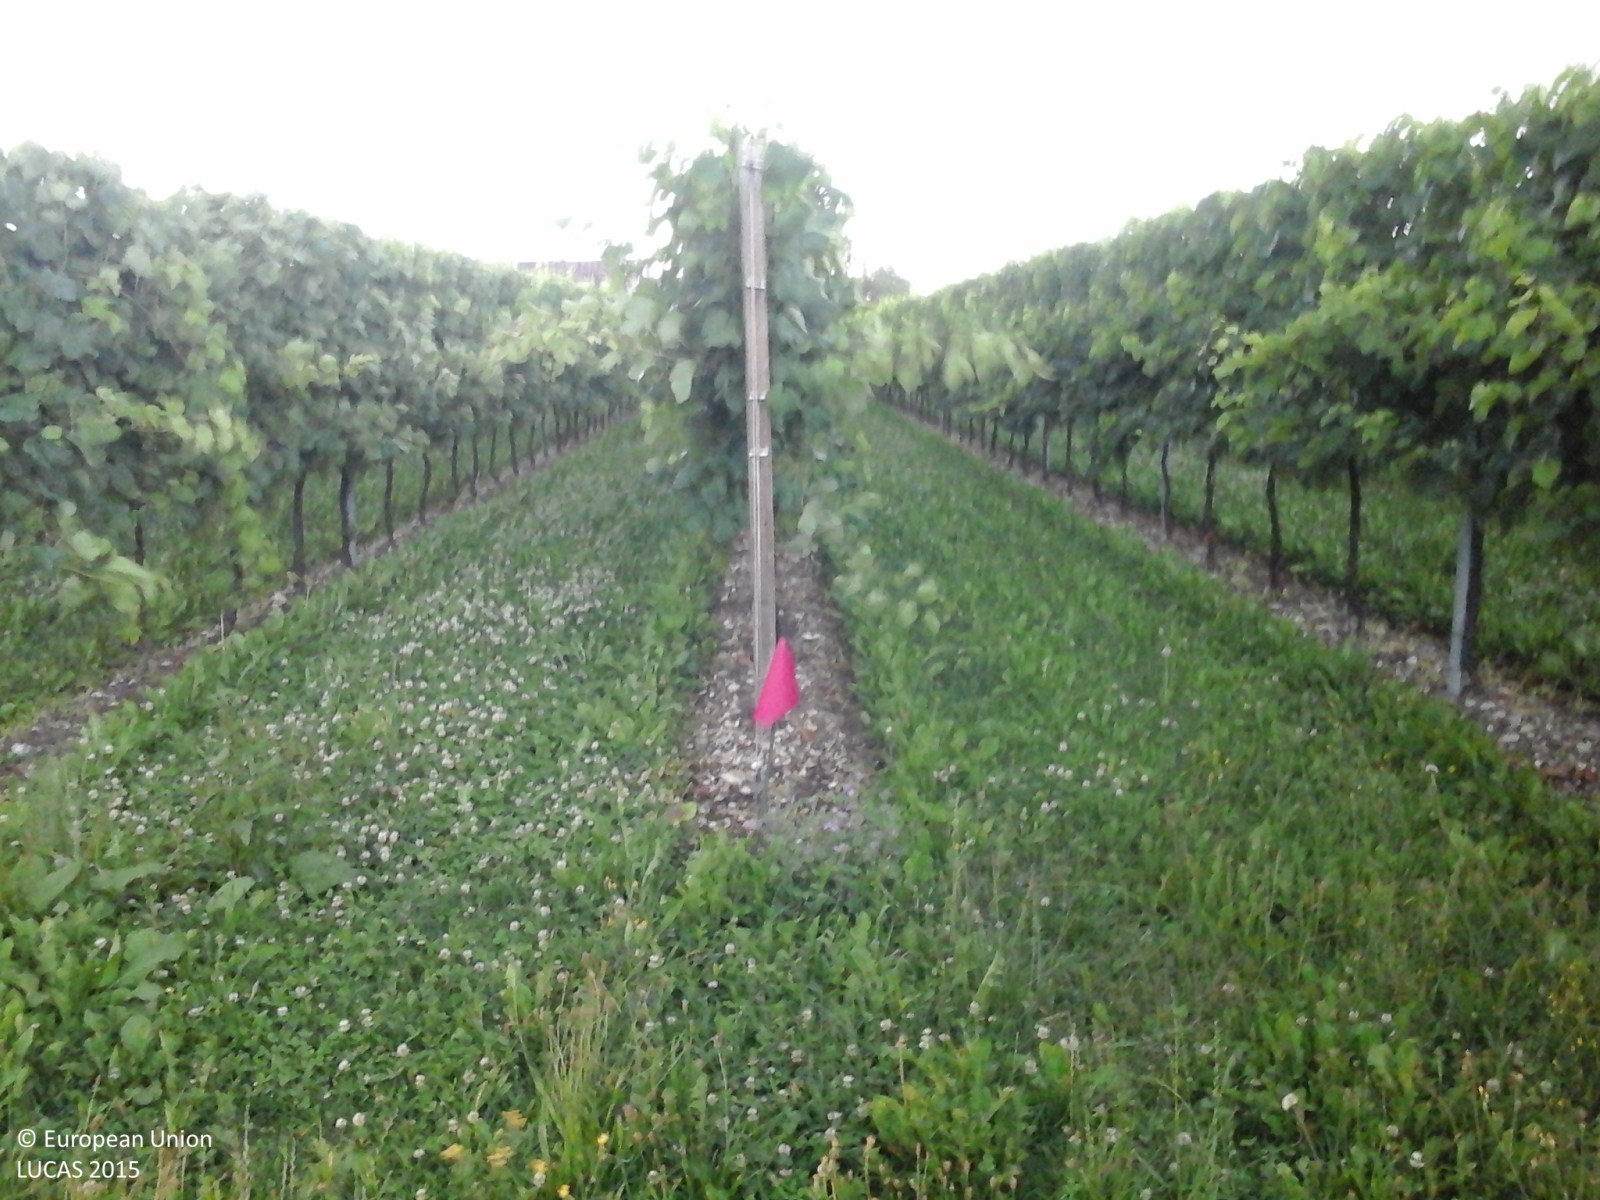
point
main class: Cropland
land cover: Vineyards
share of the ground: < 10 %
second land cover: Grassland without tree/shrub cover
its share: > 75 %
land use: Agriculture (excluding fallow land and kitchen gardens)
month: June
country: IT
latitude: 45.8393
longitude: 12.3272
